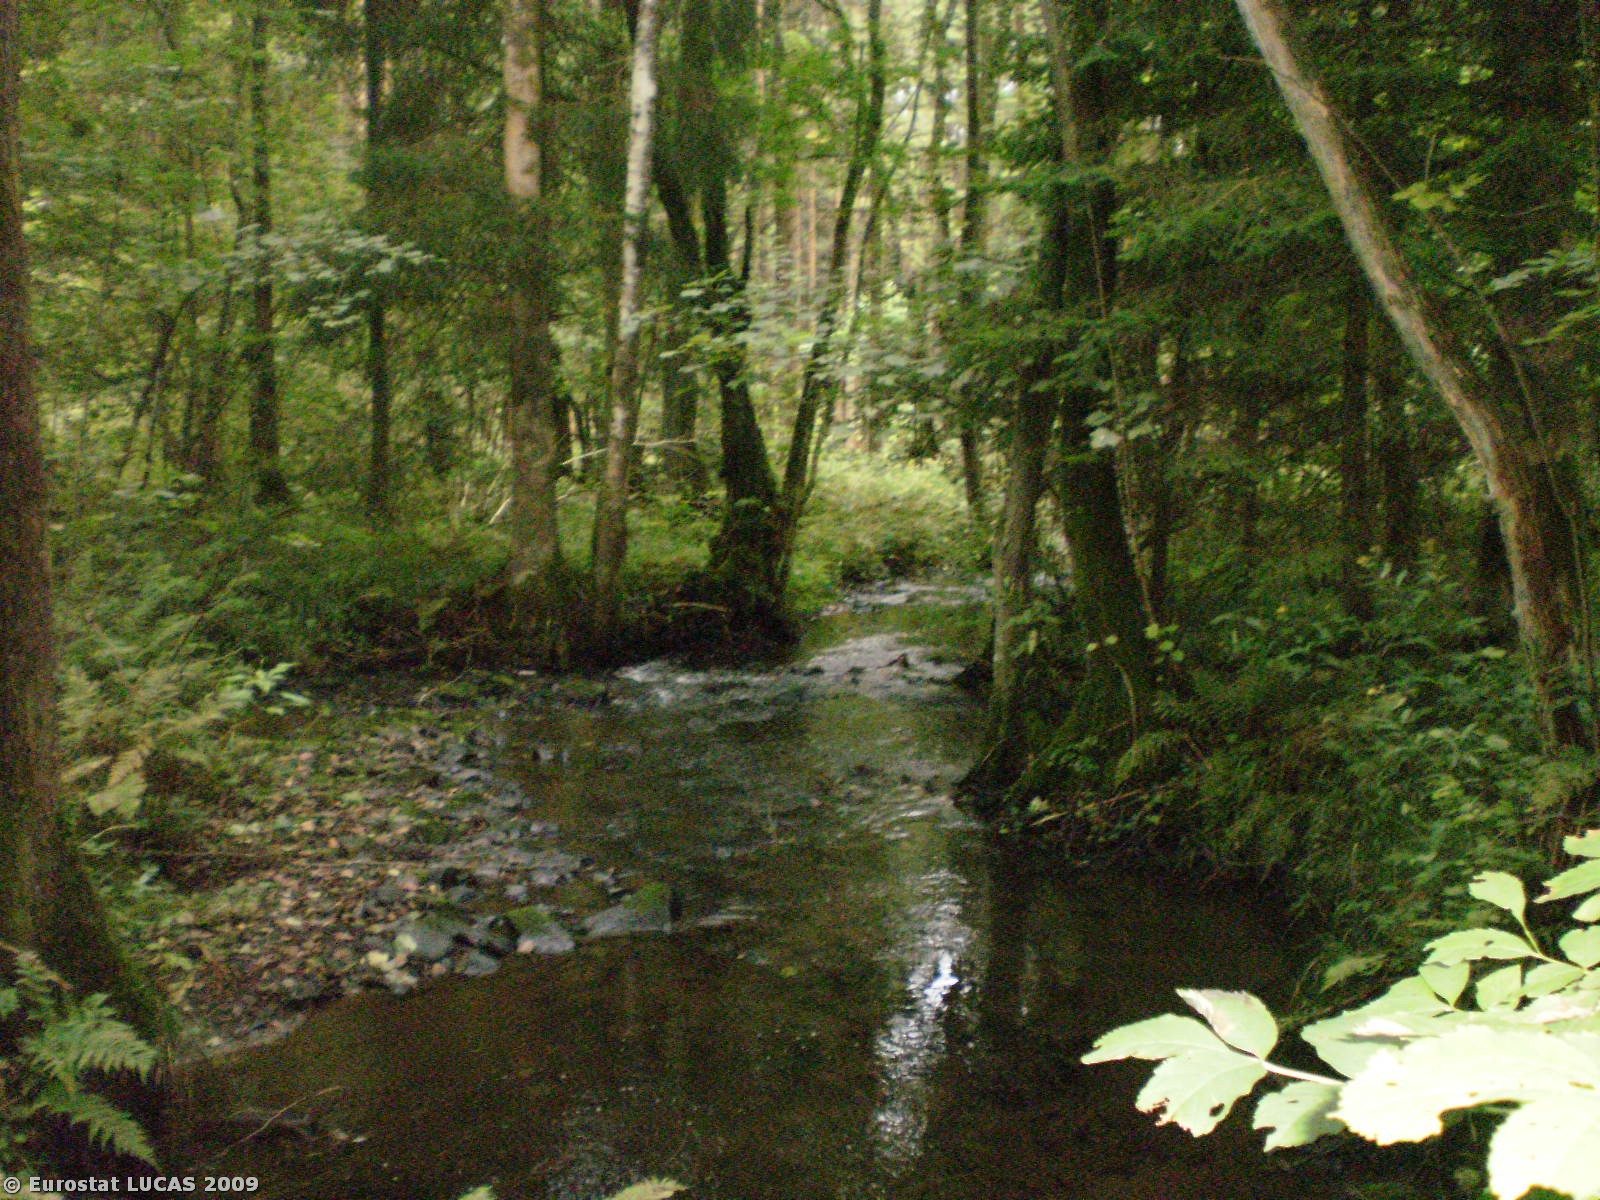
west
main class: Woodland
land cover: Mixed woodland
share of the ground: > 75 %
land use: Nature reserves
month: September
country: BE
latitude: 50.2438
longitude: 5.6094
